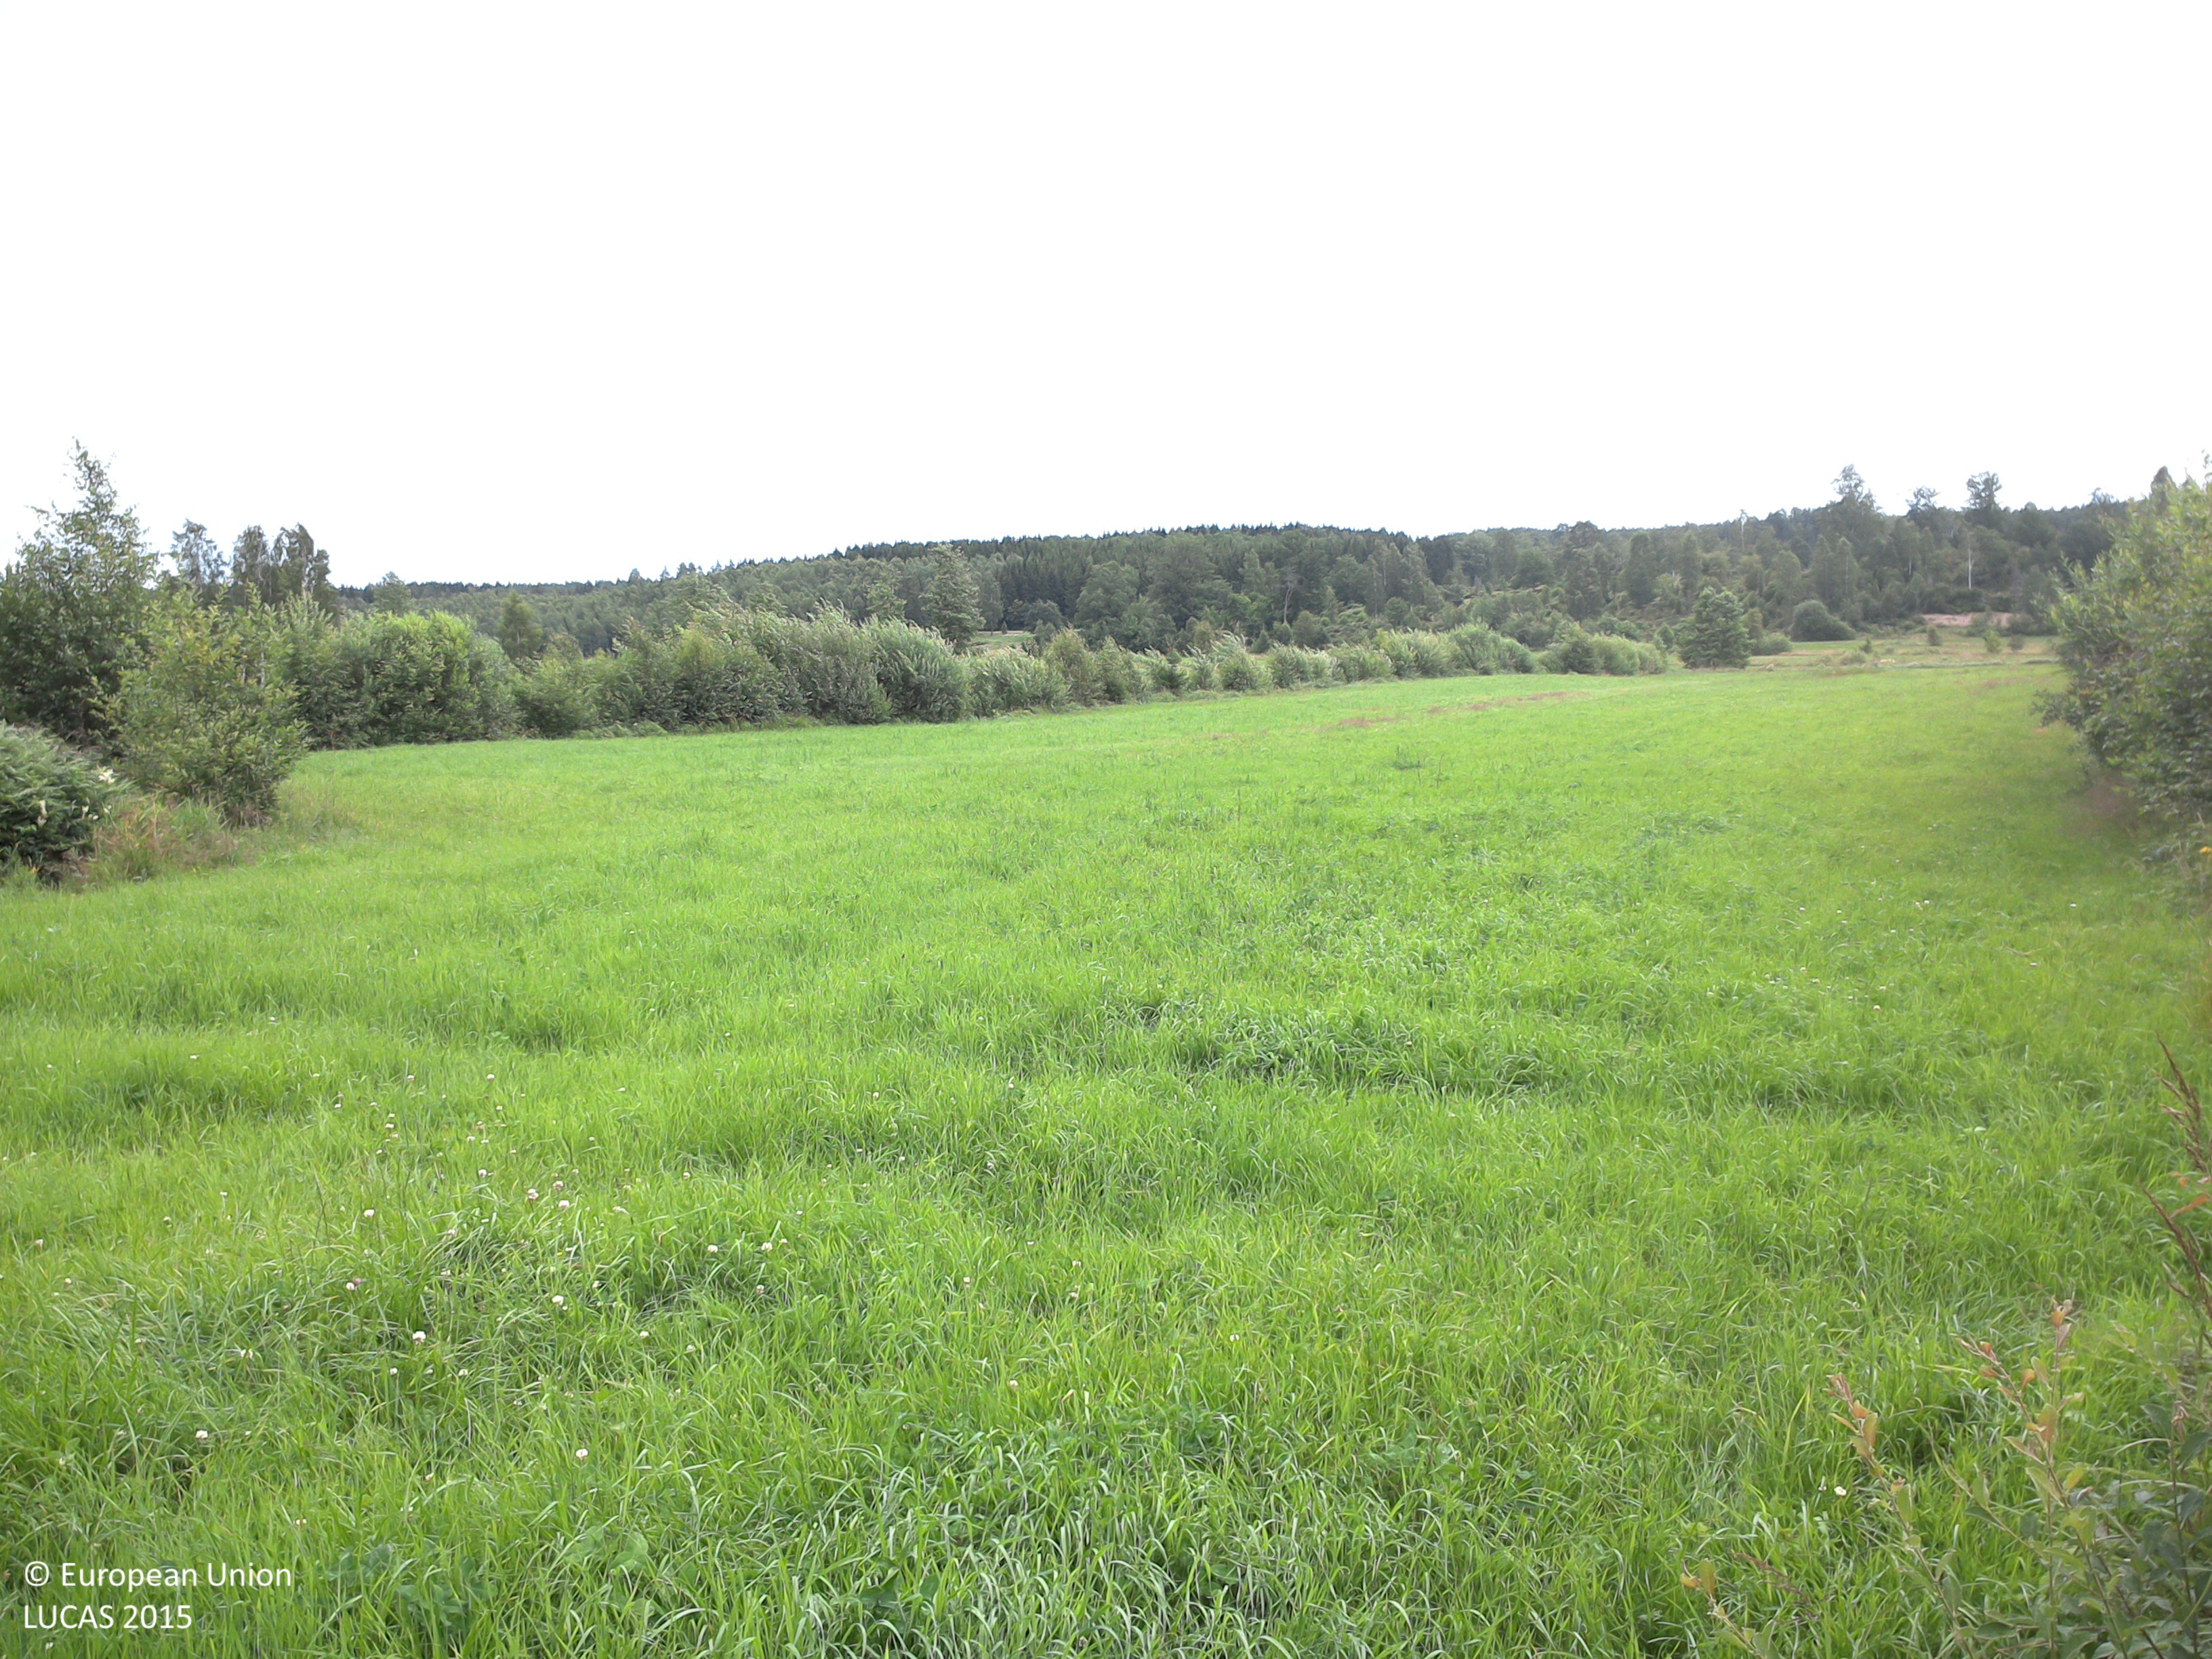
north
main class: Cropland
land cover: Other leguminous and mixtures for fodder
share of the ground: > 75 %
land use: Agriculture (excluding fallow land and kitchen gardens)
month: July
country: SE
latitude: 57.7430
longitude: 15.9944
